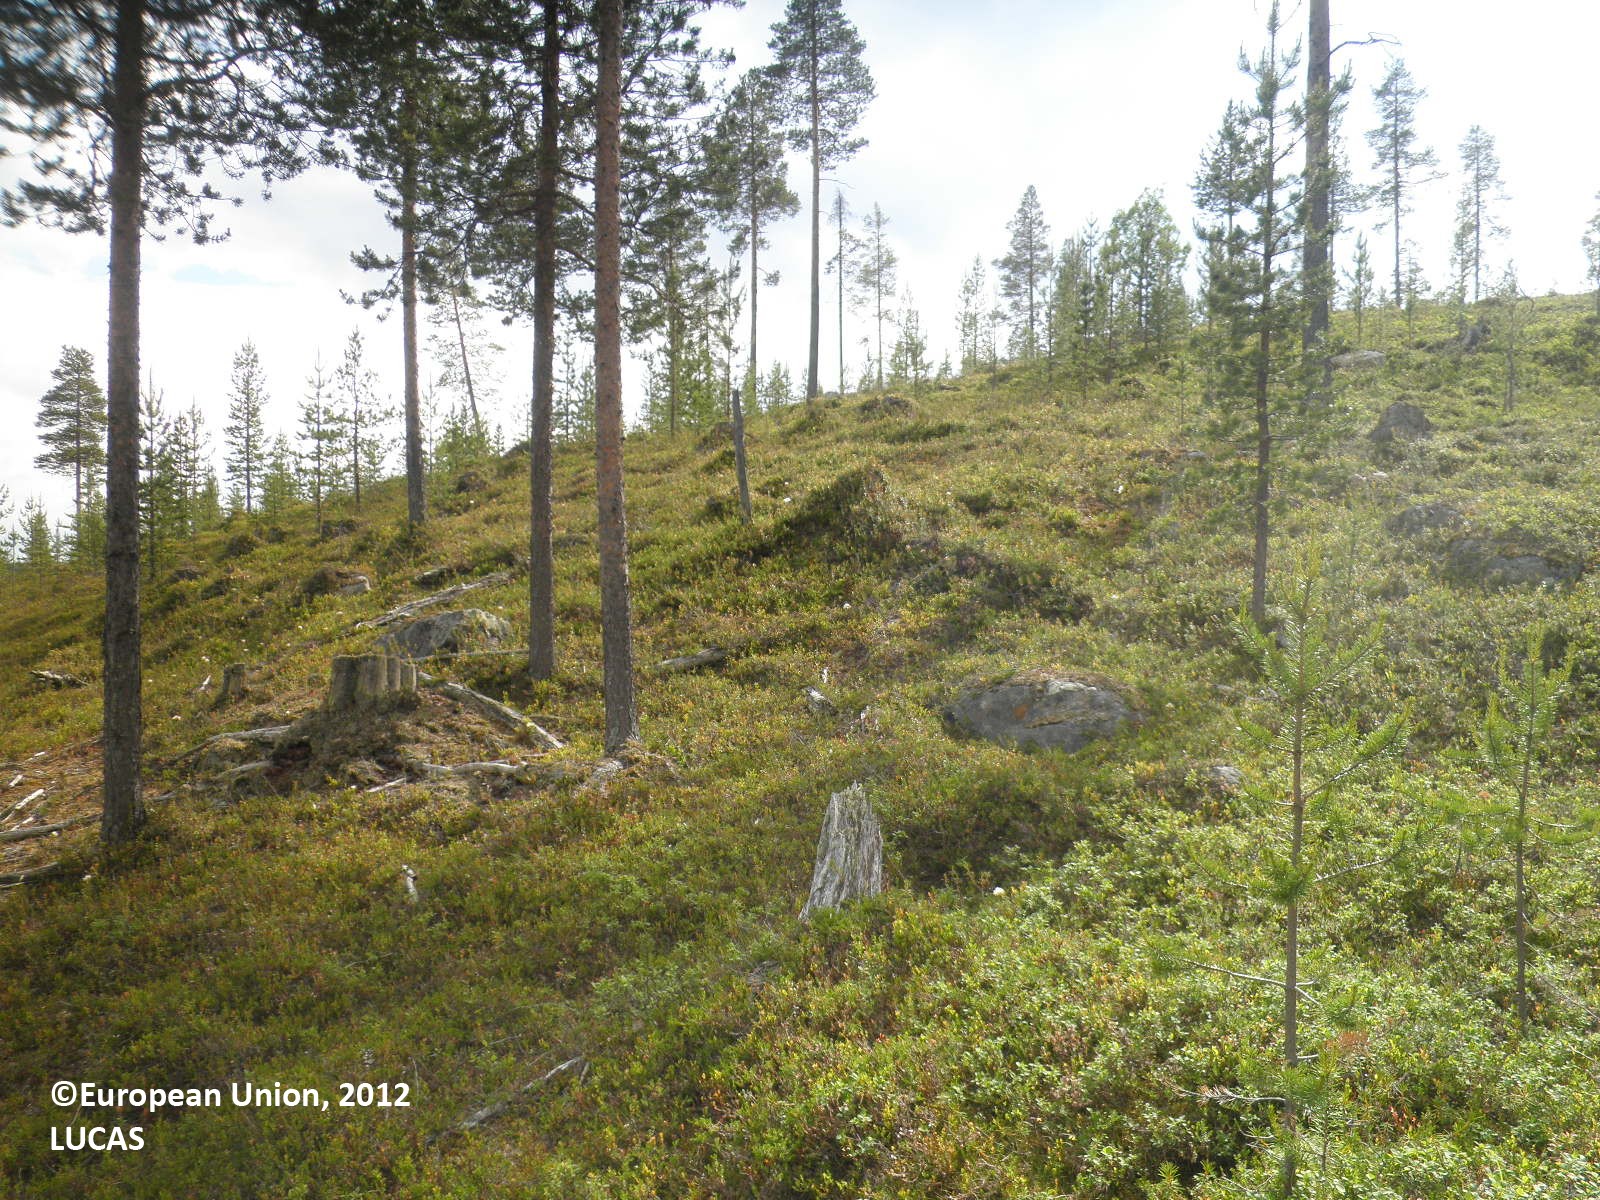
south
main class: Woodland
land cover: Pine dominated coniferous woodland
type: boreal forest
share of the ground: 10 - 25 %
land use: Forestry
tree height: > 5 m
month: July
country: FI
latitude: 68.6362
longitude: 27.9229
